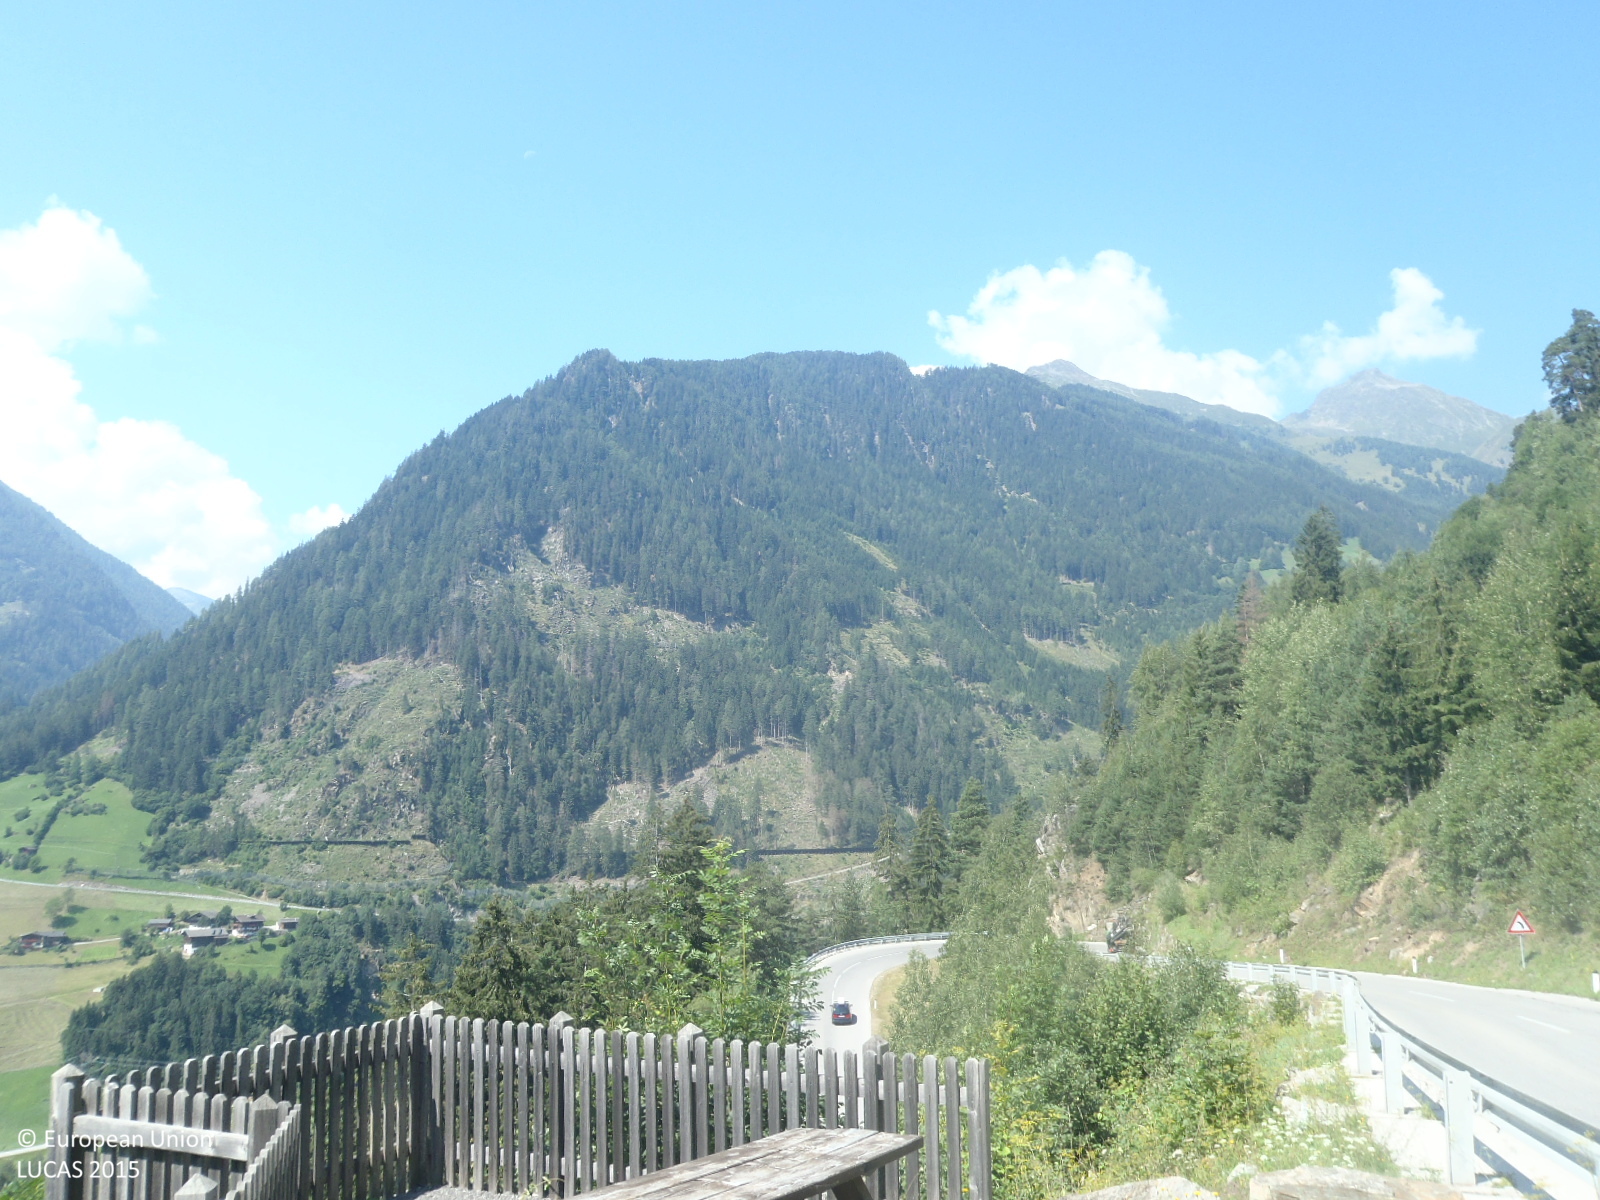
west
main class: Woodland
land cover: Broadleaved woodland
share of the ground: > 75 %
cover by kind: broadleaved forest trees 95 %, shrubs 5 %
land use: Forestry
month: August
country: AT
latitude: 46.9326
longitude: 12.5853
